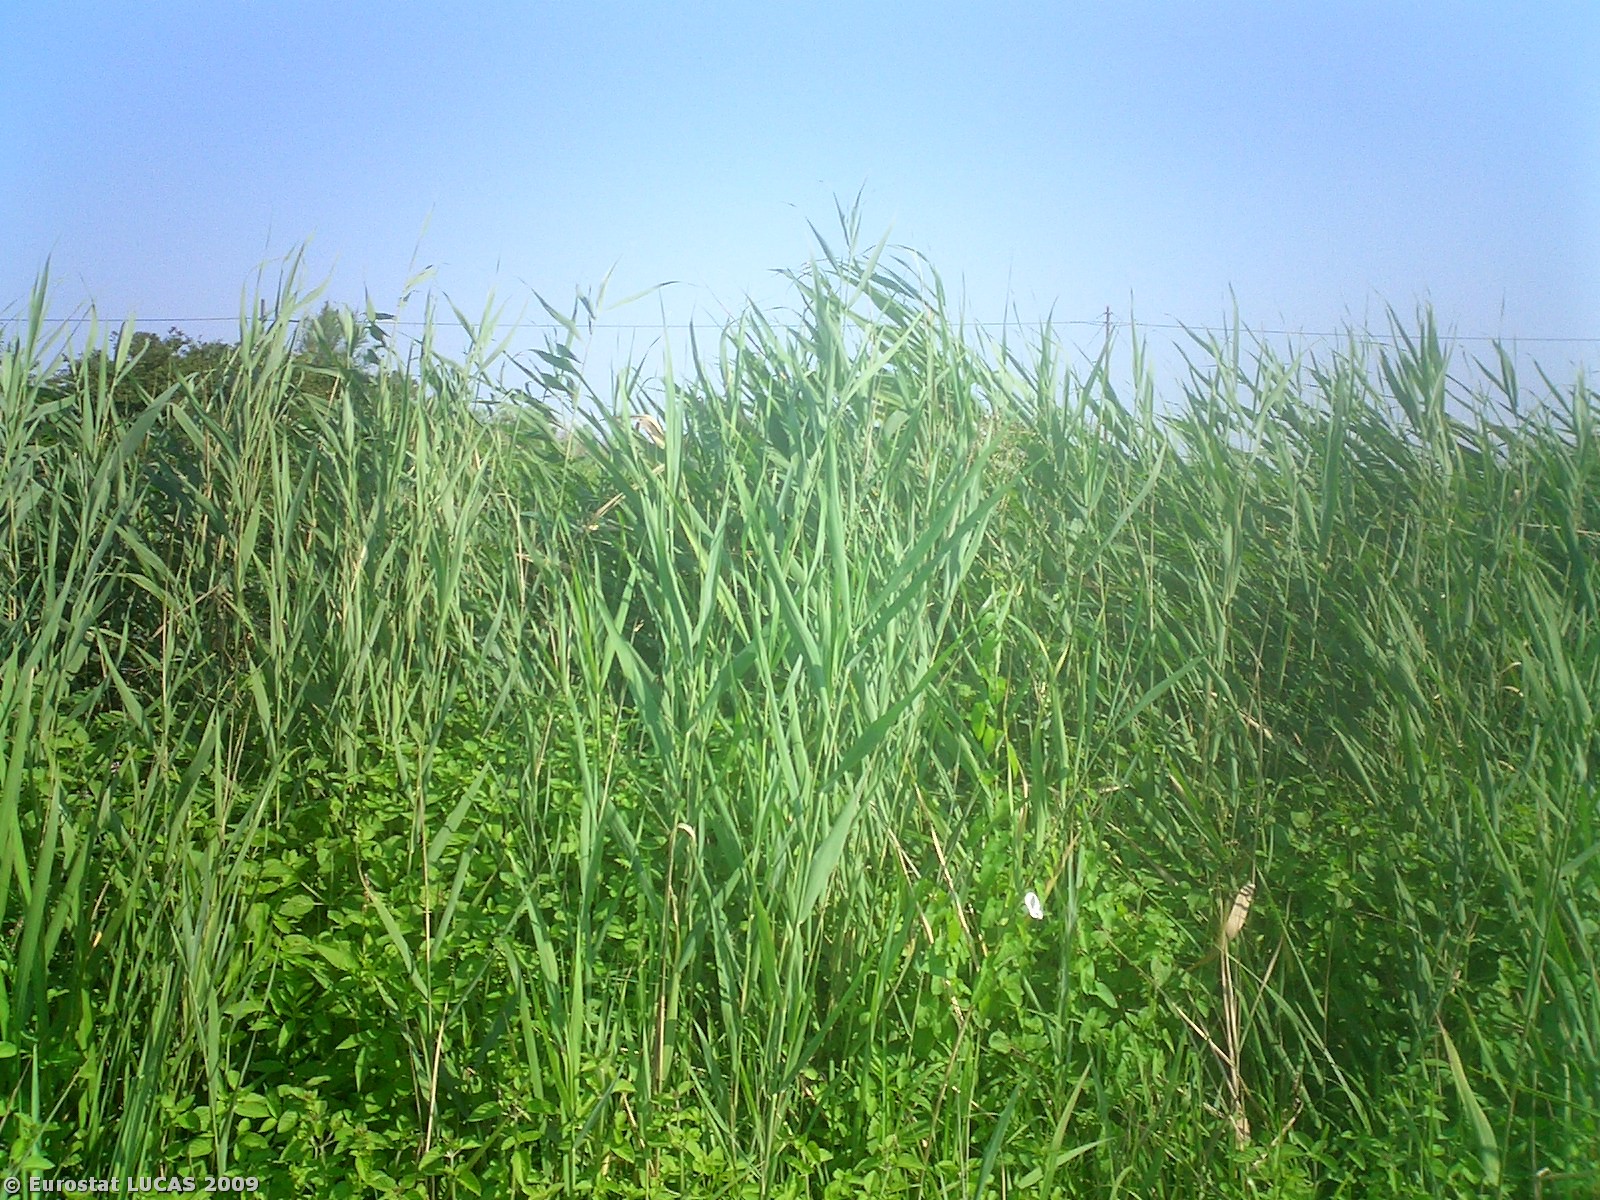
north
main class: Grassland
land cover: Grassland without tree/shrub cover
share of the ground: > 75 %
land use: Agriculture (excluding fallow land and kitchen gardens)
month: July
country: IT
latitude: 44.8347
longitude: 12.0832
